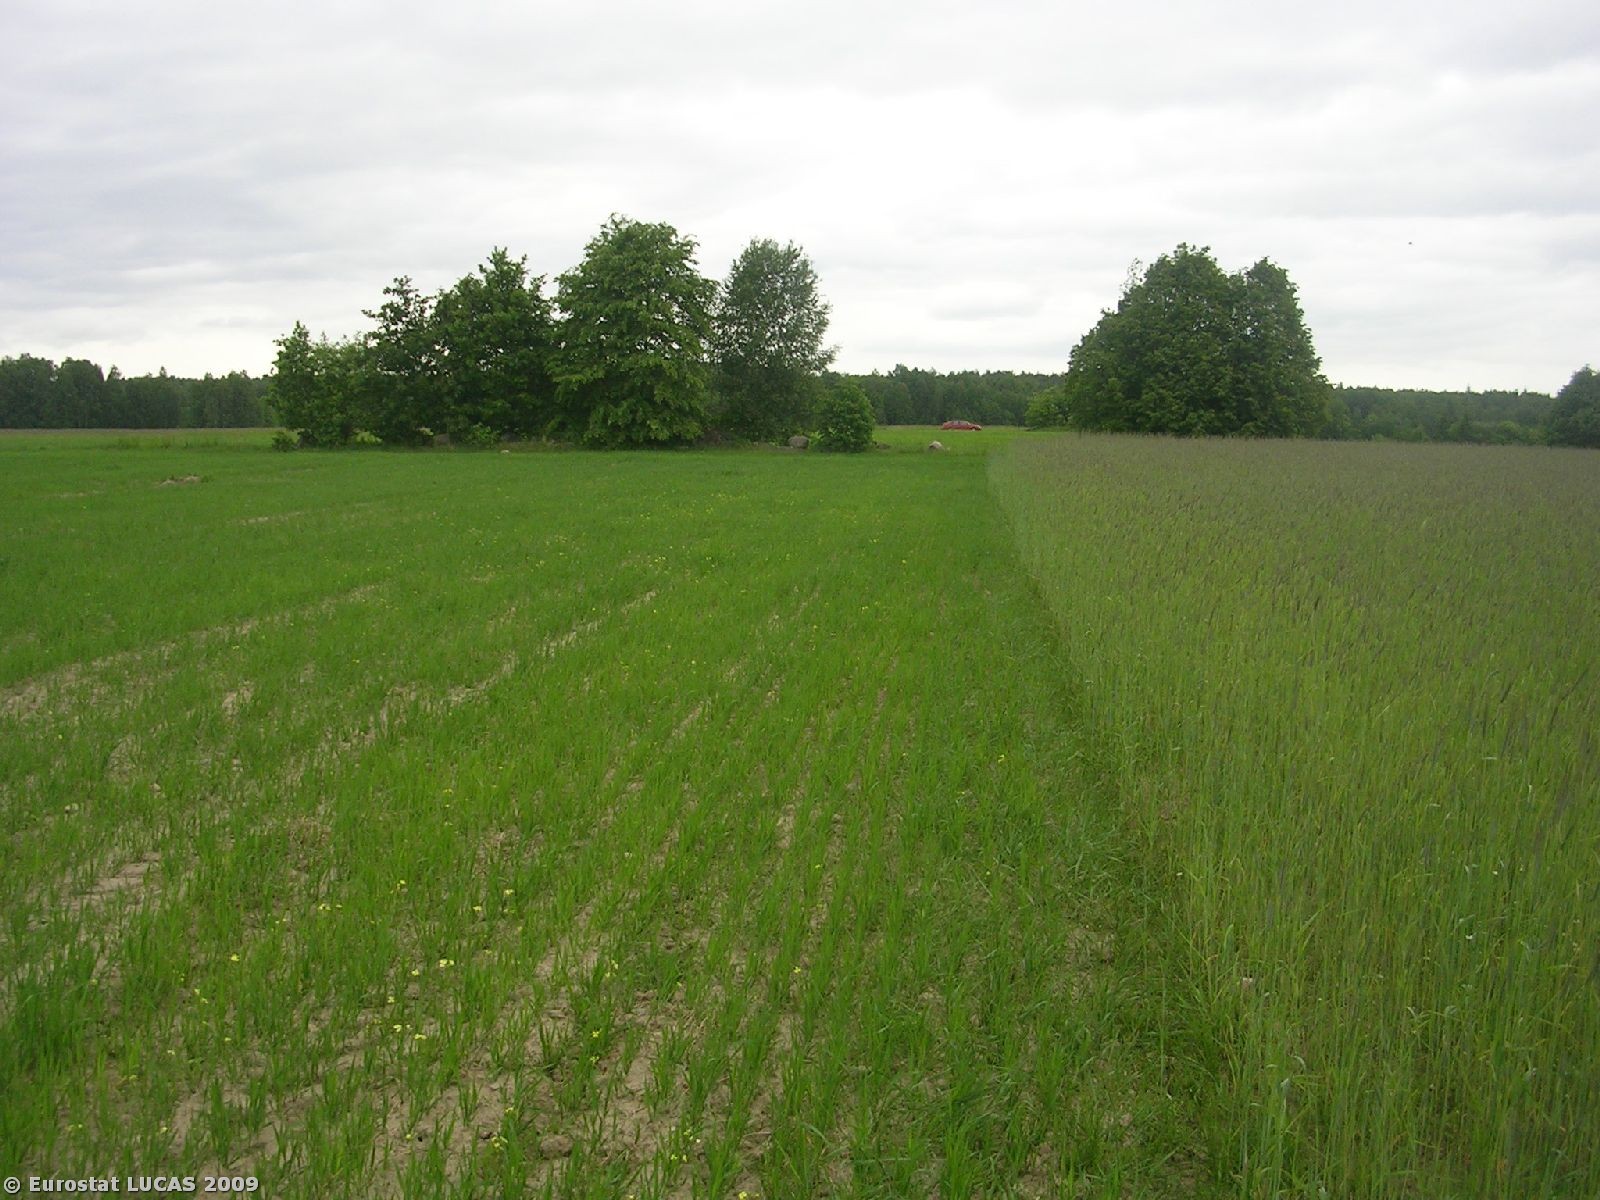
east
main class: Cropland
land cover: Barley
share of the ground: 25 - 50 %
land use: Agriculture (excluding fallow land and kitchen gardens)
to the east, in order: Barley; Grass margins; Single bushes/trees; Barley; Grass margins; Paved roads, cycling and walking lanes; Grass margins; Rye
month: May
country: PL
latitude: 53.5742
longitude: 23.4784
